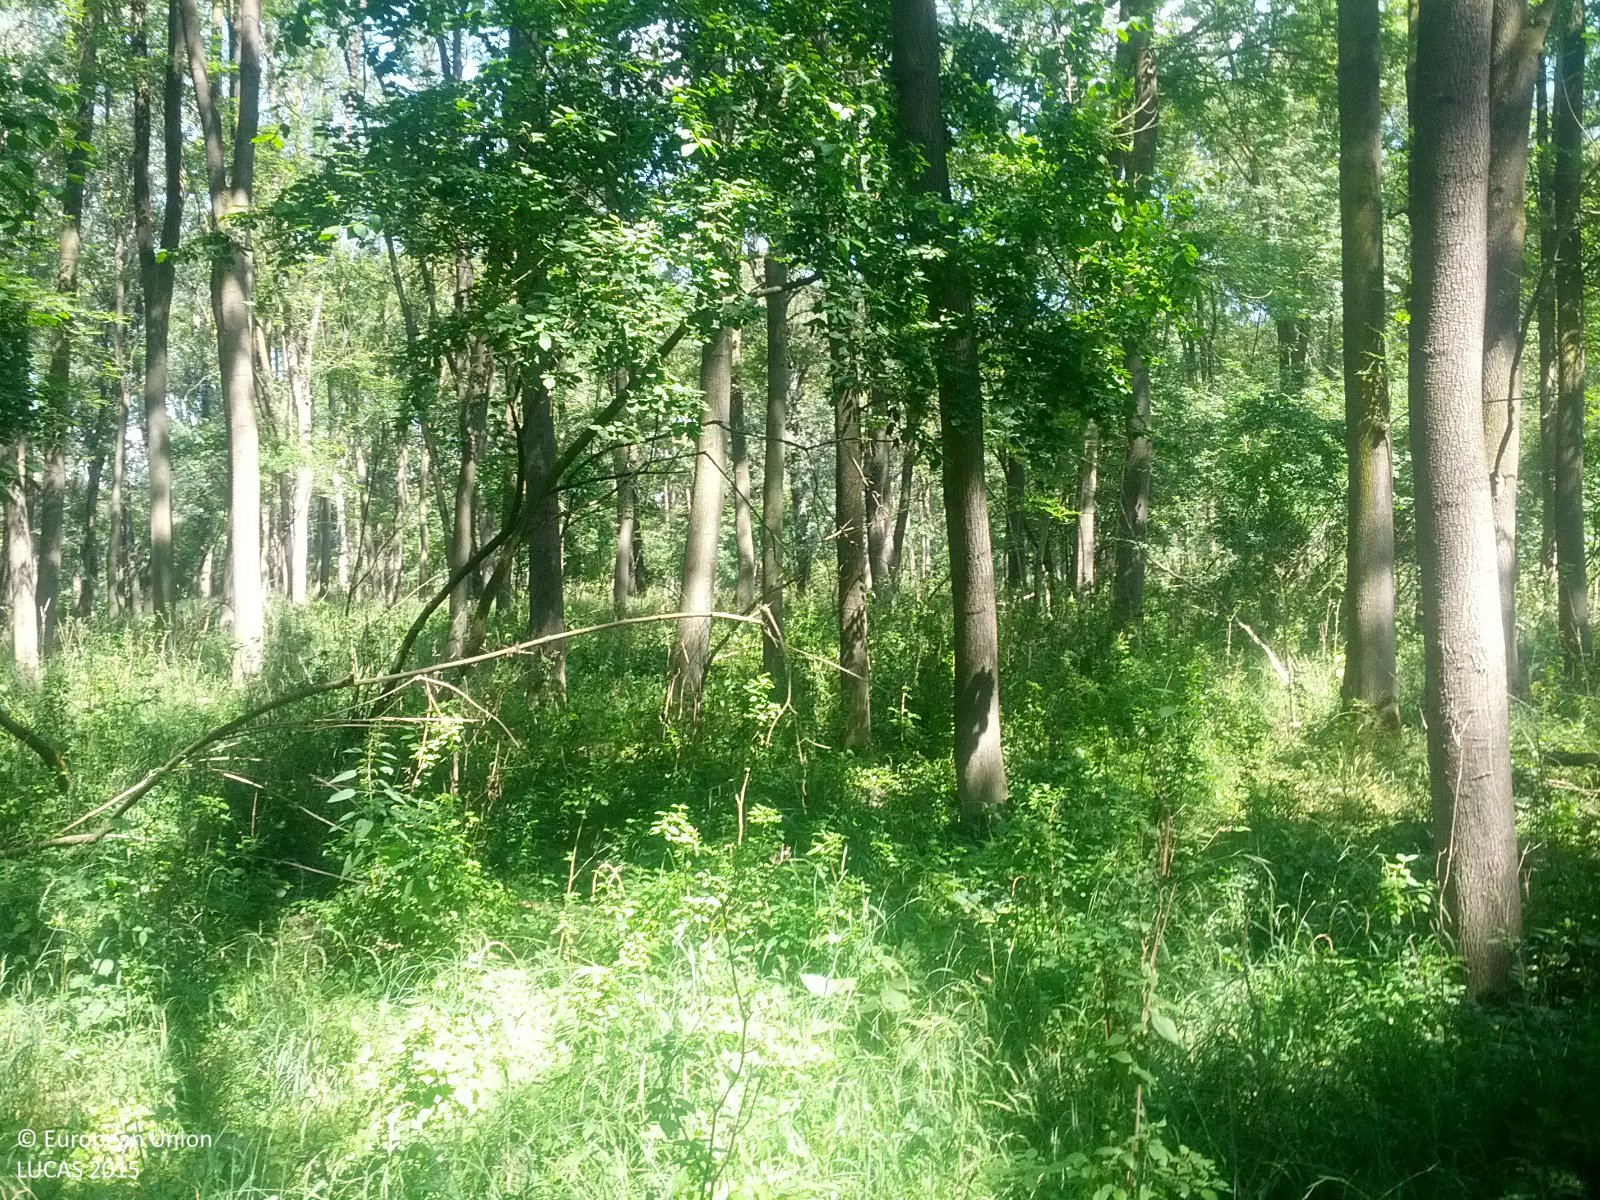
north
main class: Woodland
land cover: Broadleaved woodland
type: floodplain forest
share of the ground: > 75 %
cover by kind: broadleaved forest trees 85 %, herbaceous plants 15 %
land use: Forestry
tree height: > 5 m
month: July
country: AT
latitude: 48.3454
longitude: 16.0624
